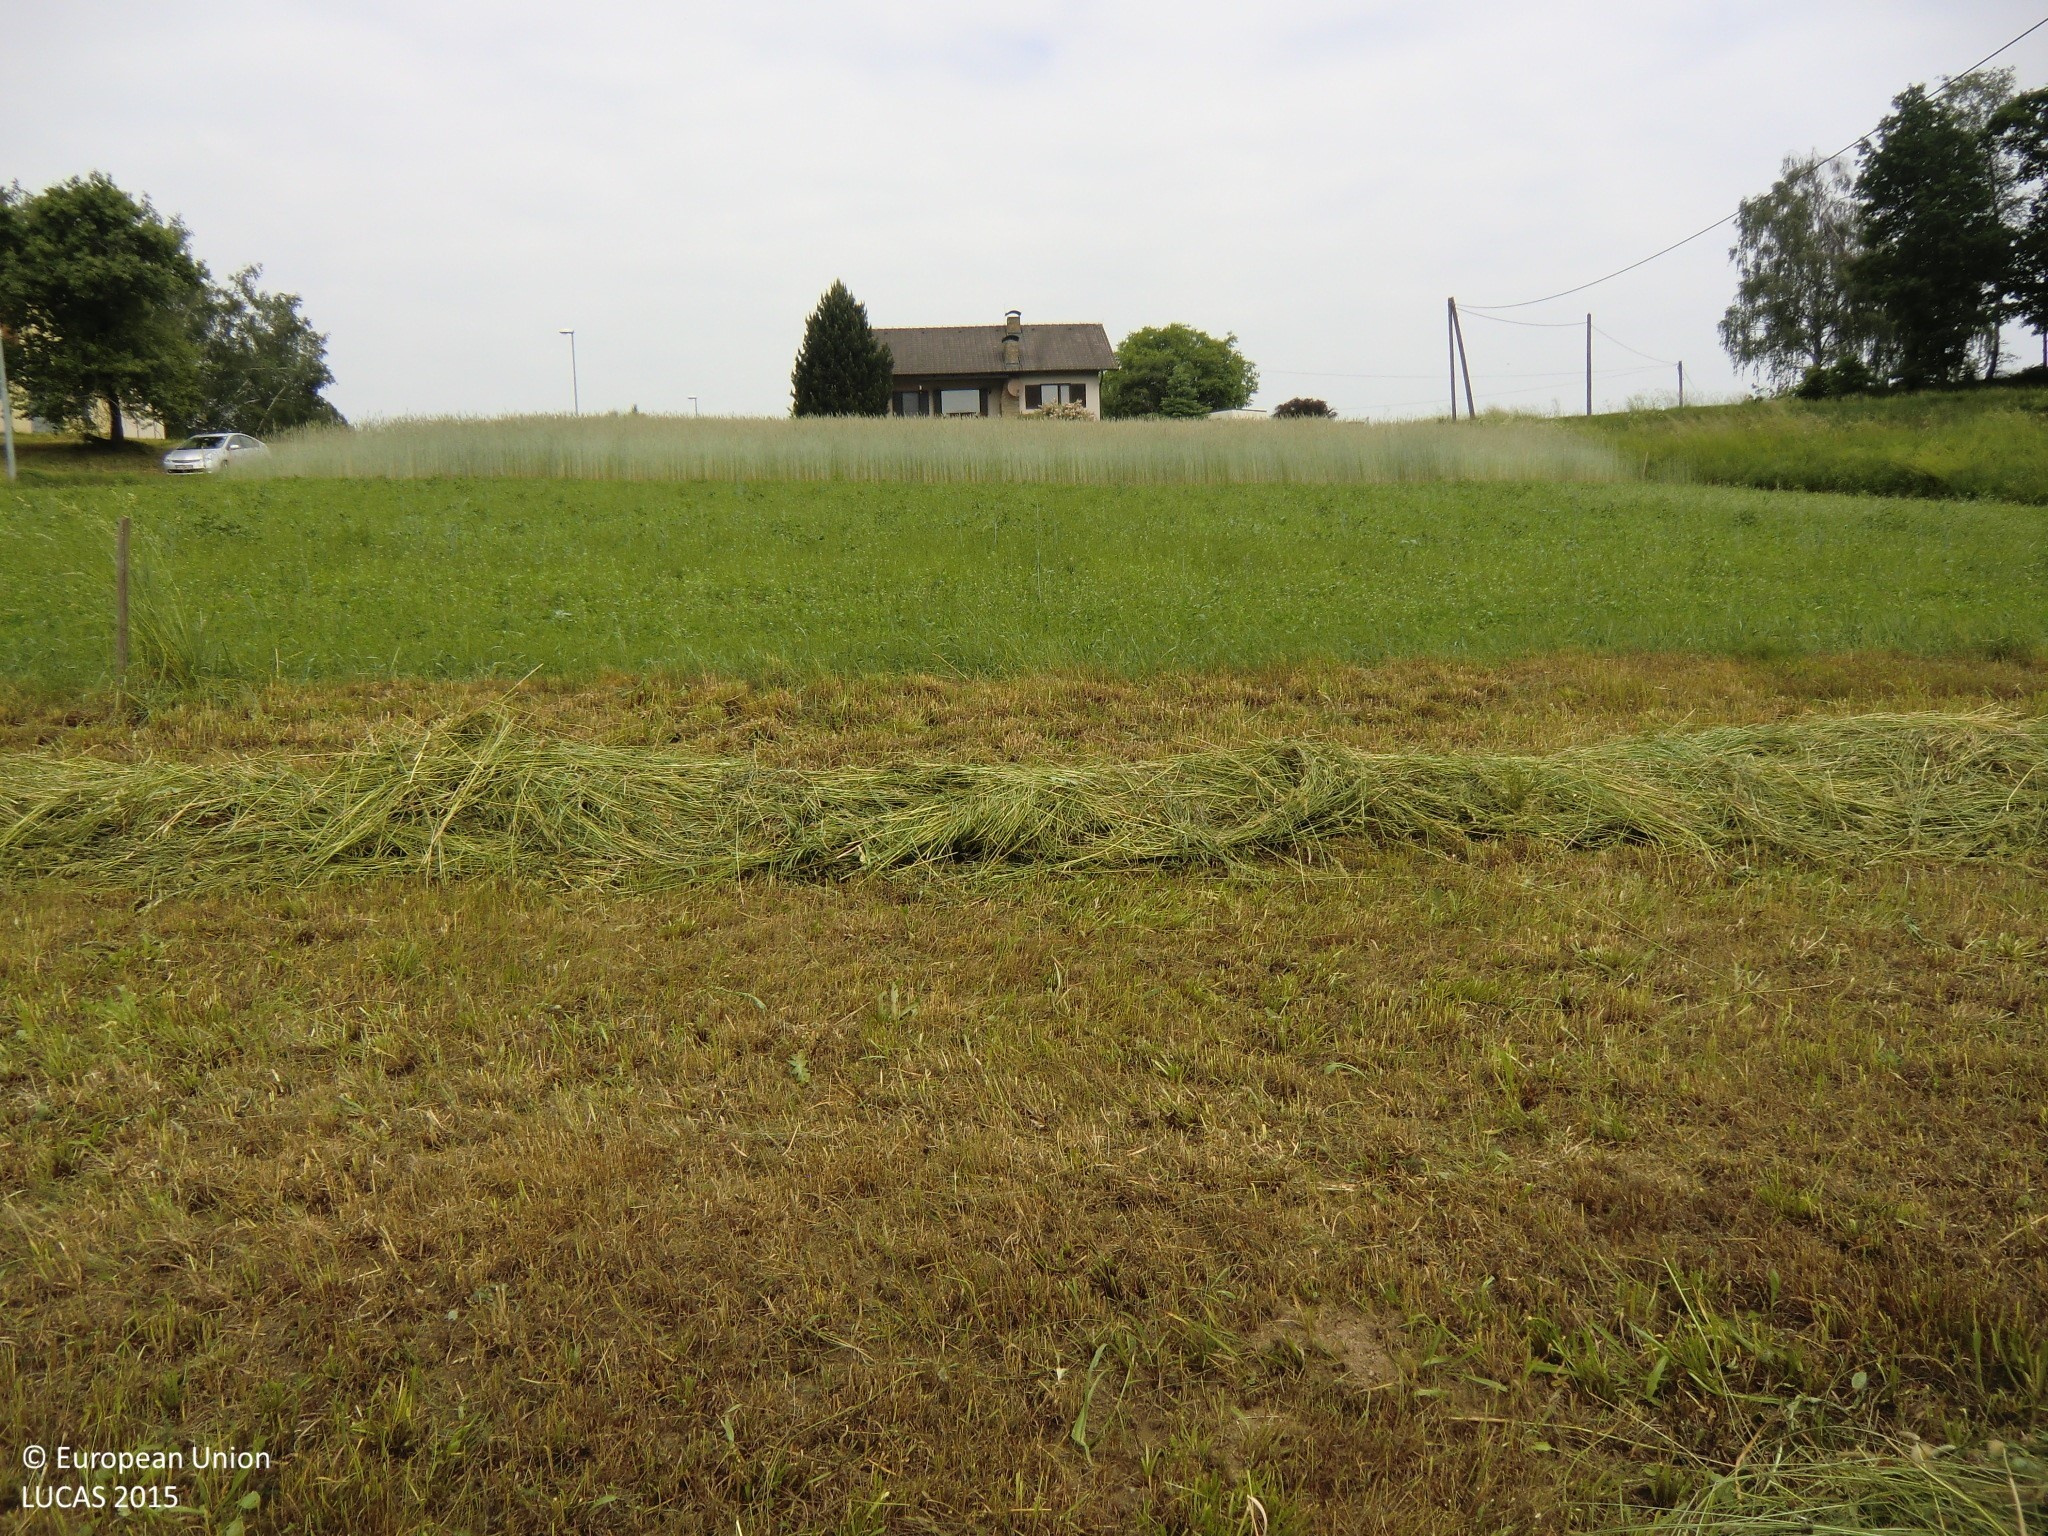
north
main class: Grassland
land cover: Grassland without tree/shrub cover
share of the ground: > 75 %
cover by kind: herbaceous plants 100 %
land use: Agriculture (excluding fallow land and kitchen gardens)
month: June
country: AT
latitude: 48.6313
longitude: 15.0358
